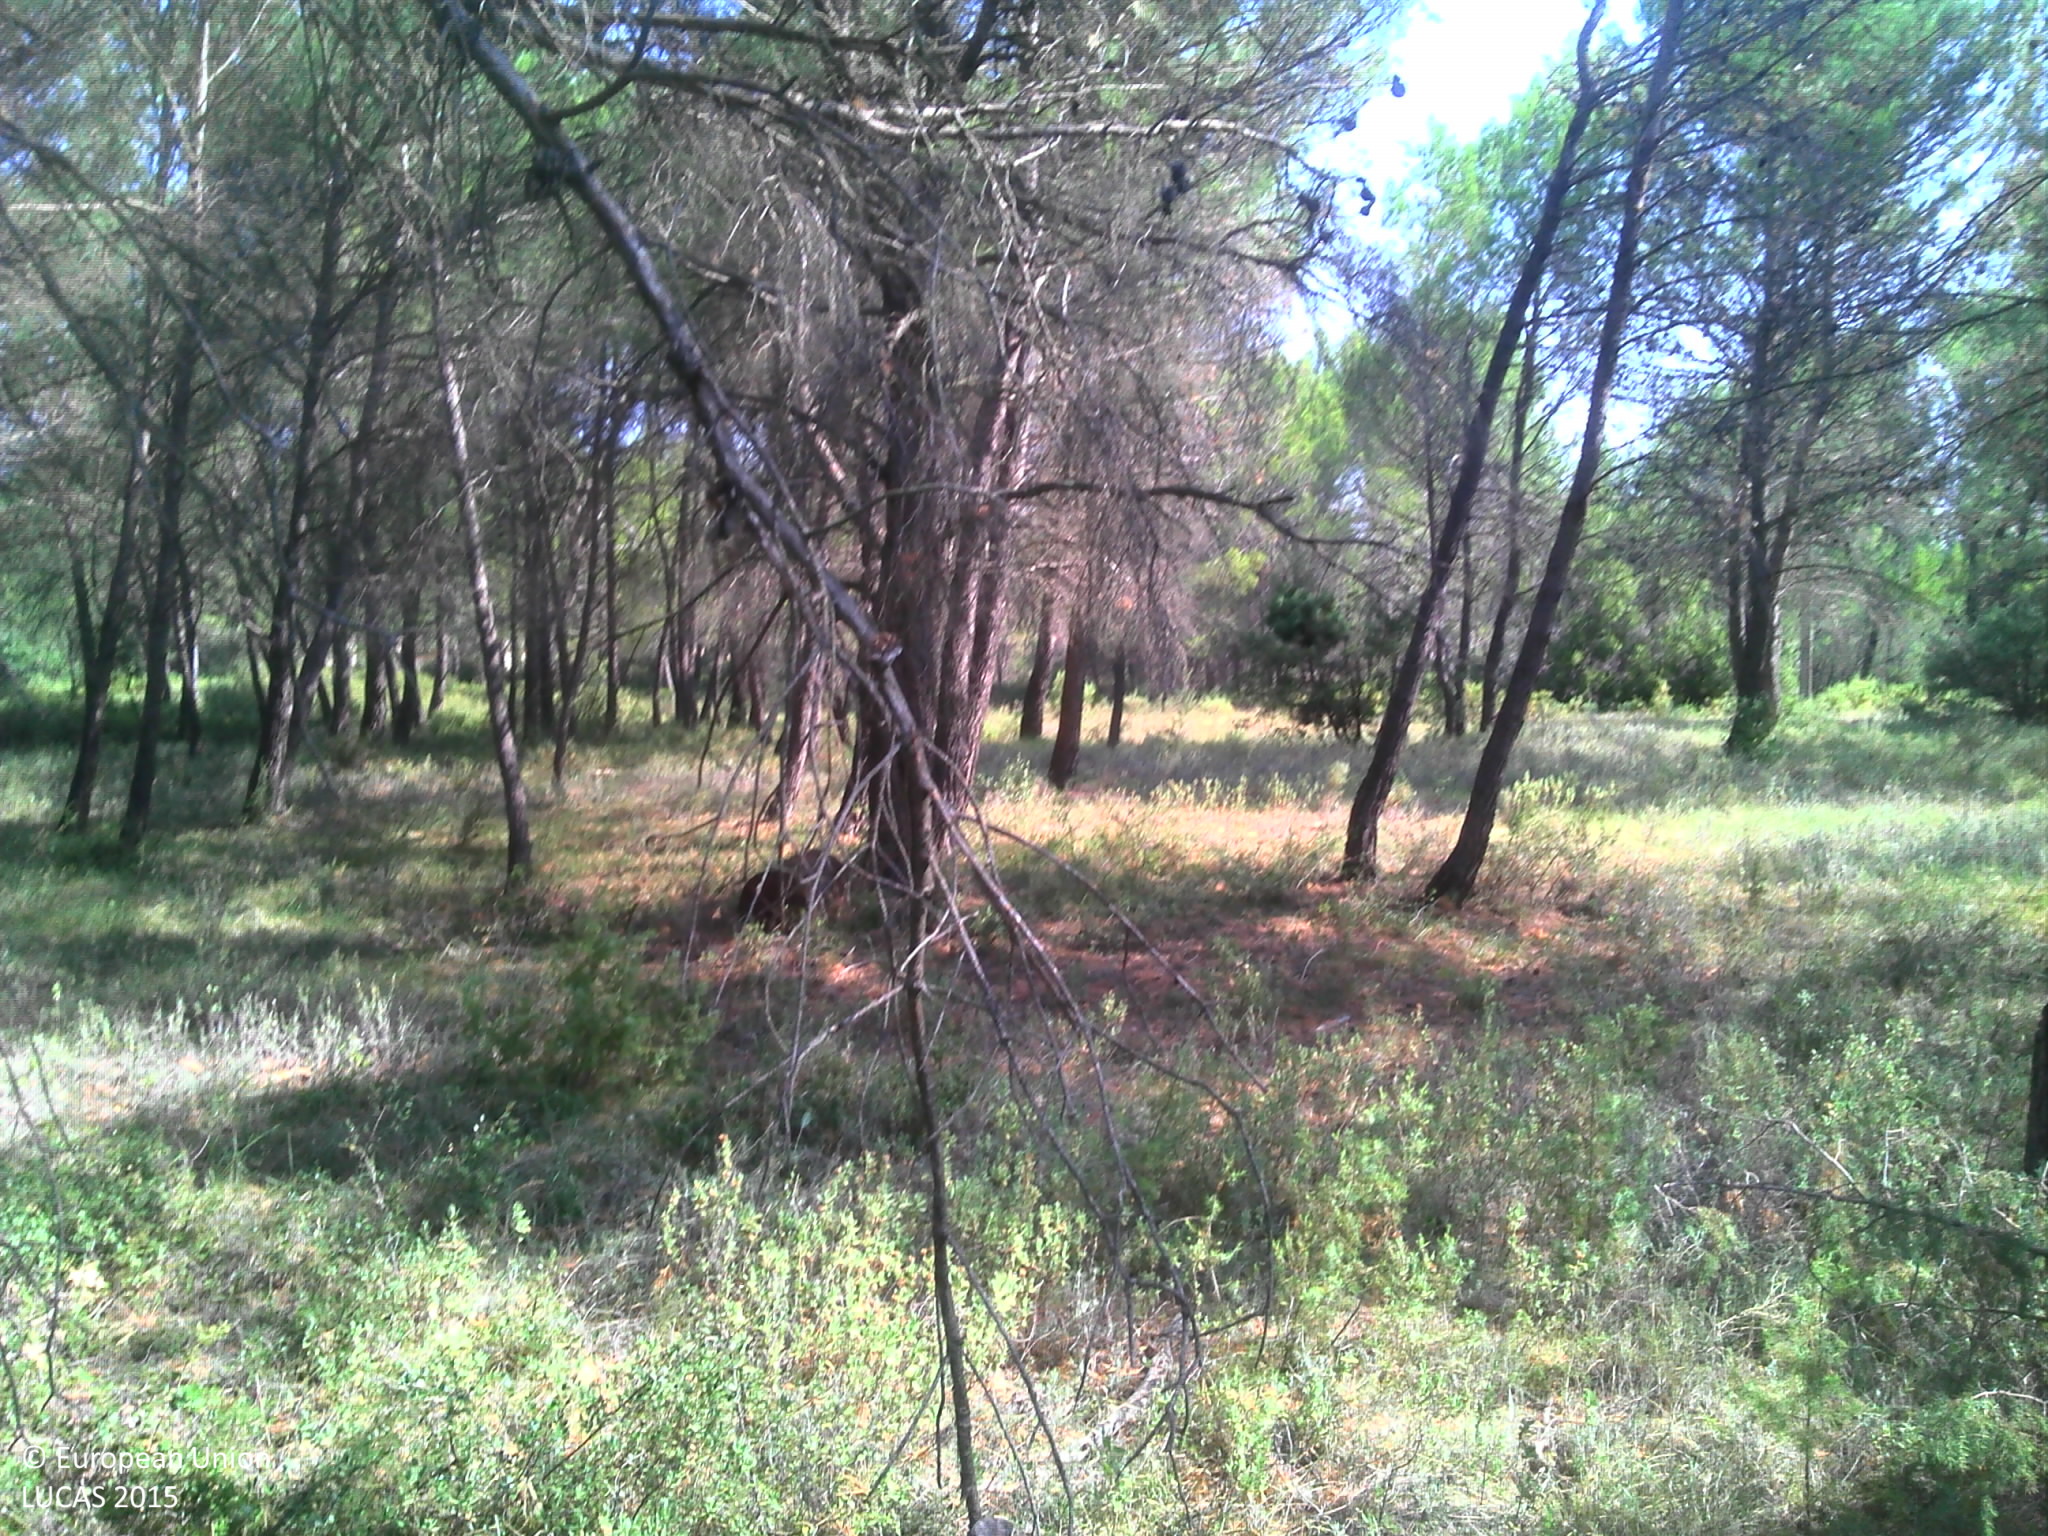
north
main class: Woodland
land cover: Pine dominated coniferous woodland
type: coniferous forest of the mediterranean region
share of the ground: > 75 %
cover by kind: coniferous forest trees 60 %, herbaceous plants 20 %, shrubs 15 %, broadleaved forest trees 5 %
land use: Residential
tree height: > 5 m
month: July
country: FR
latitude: 43.6281
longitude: 5.2627
